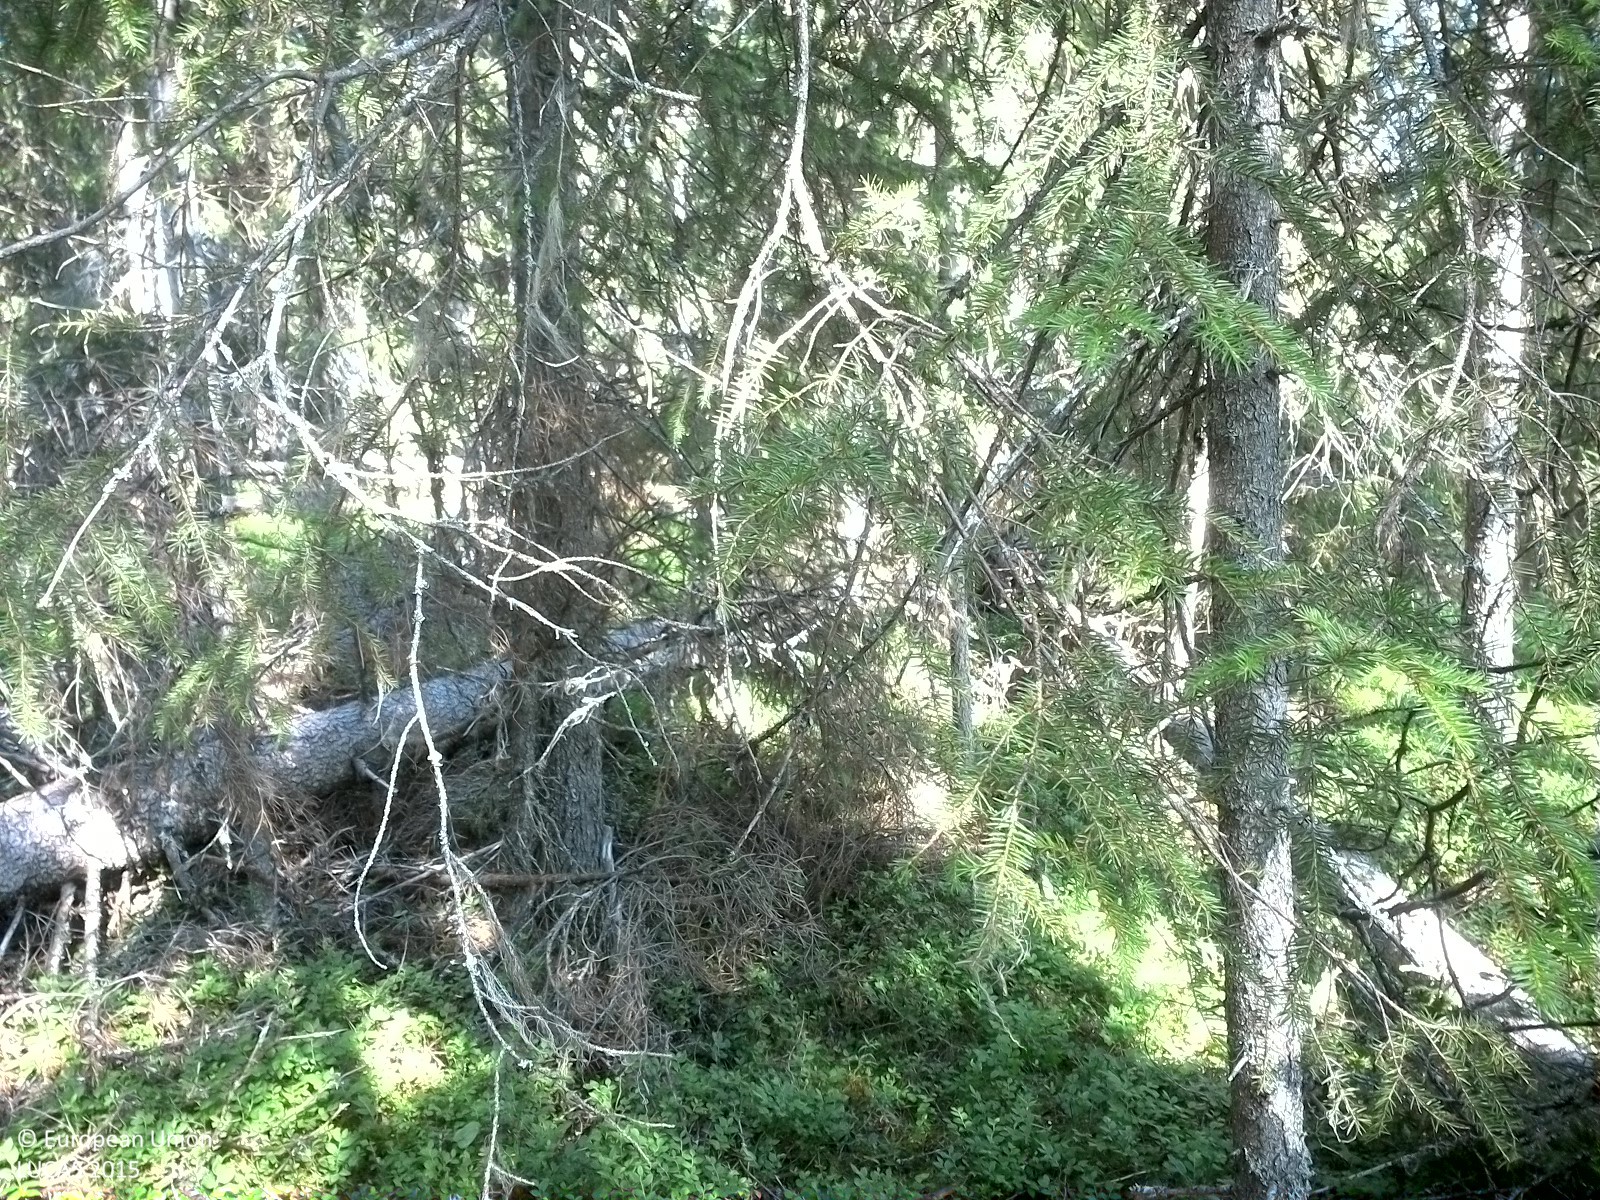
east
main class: Woodland
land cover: Spruce dominated coniferous woodland
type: boreal forest
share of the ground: > 75 %
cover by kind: coniferous forest trees 80 %, shrubs 20 %
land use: Forestry
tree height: > 5 m
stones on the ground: < 10 %
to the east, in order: Spruce dominated coniferous woodland; Artificial constructions in urban areas; Grassland without tree/shrub cover; Spruce dominated coniferous woodland
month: July
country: SE
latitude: 63.6267
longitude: 15.1609
